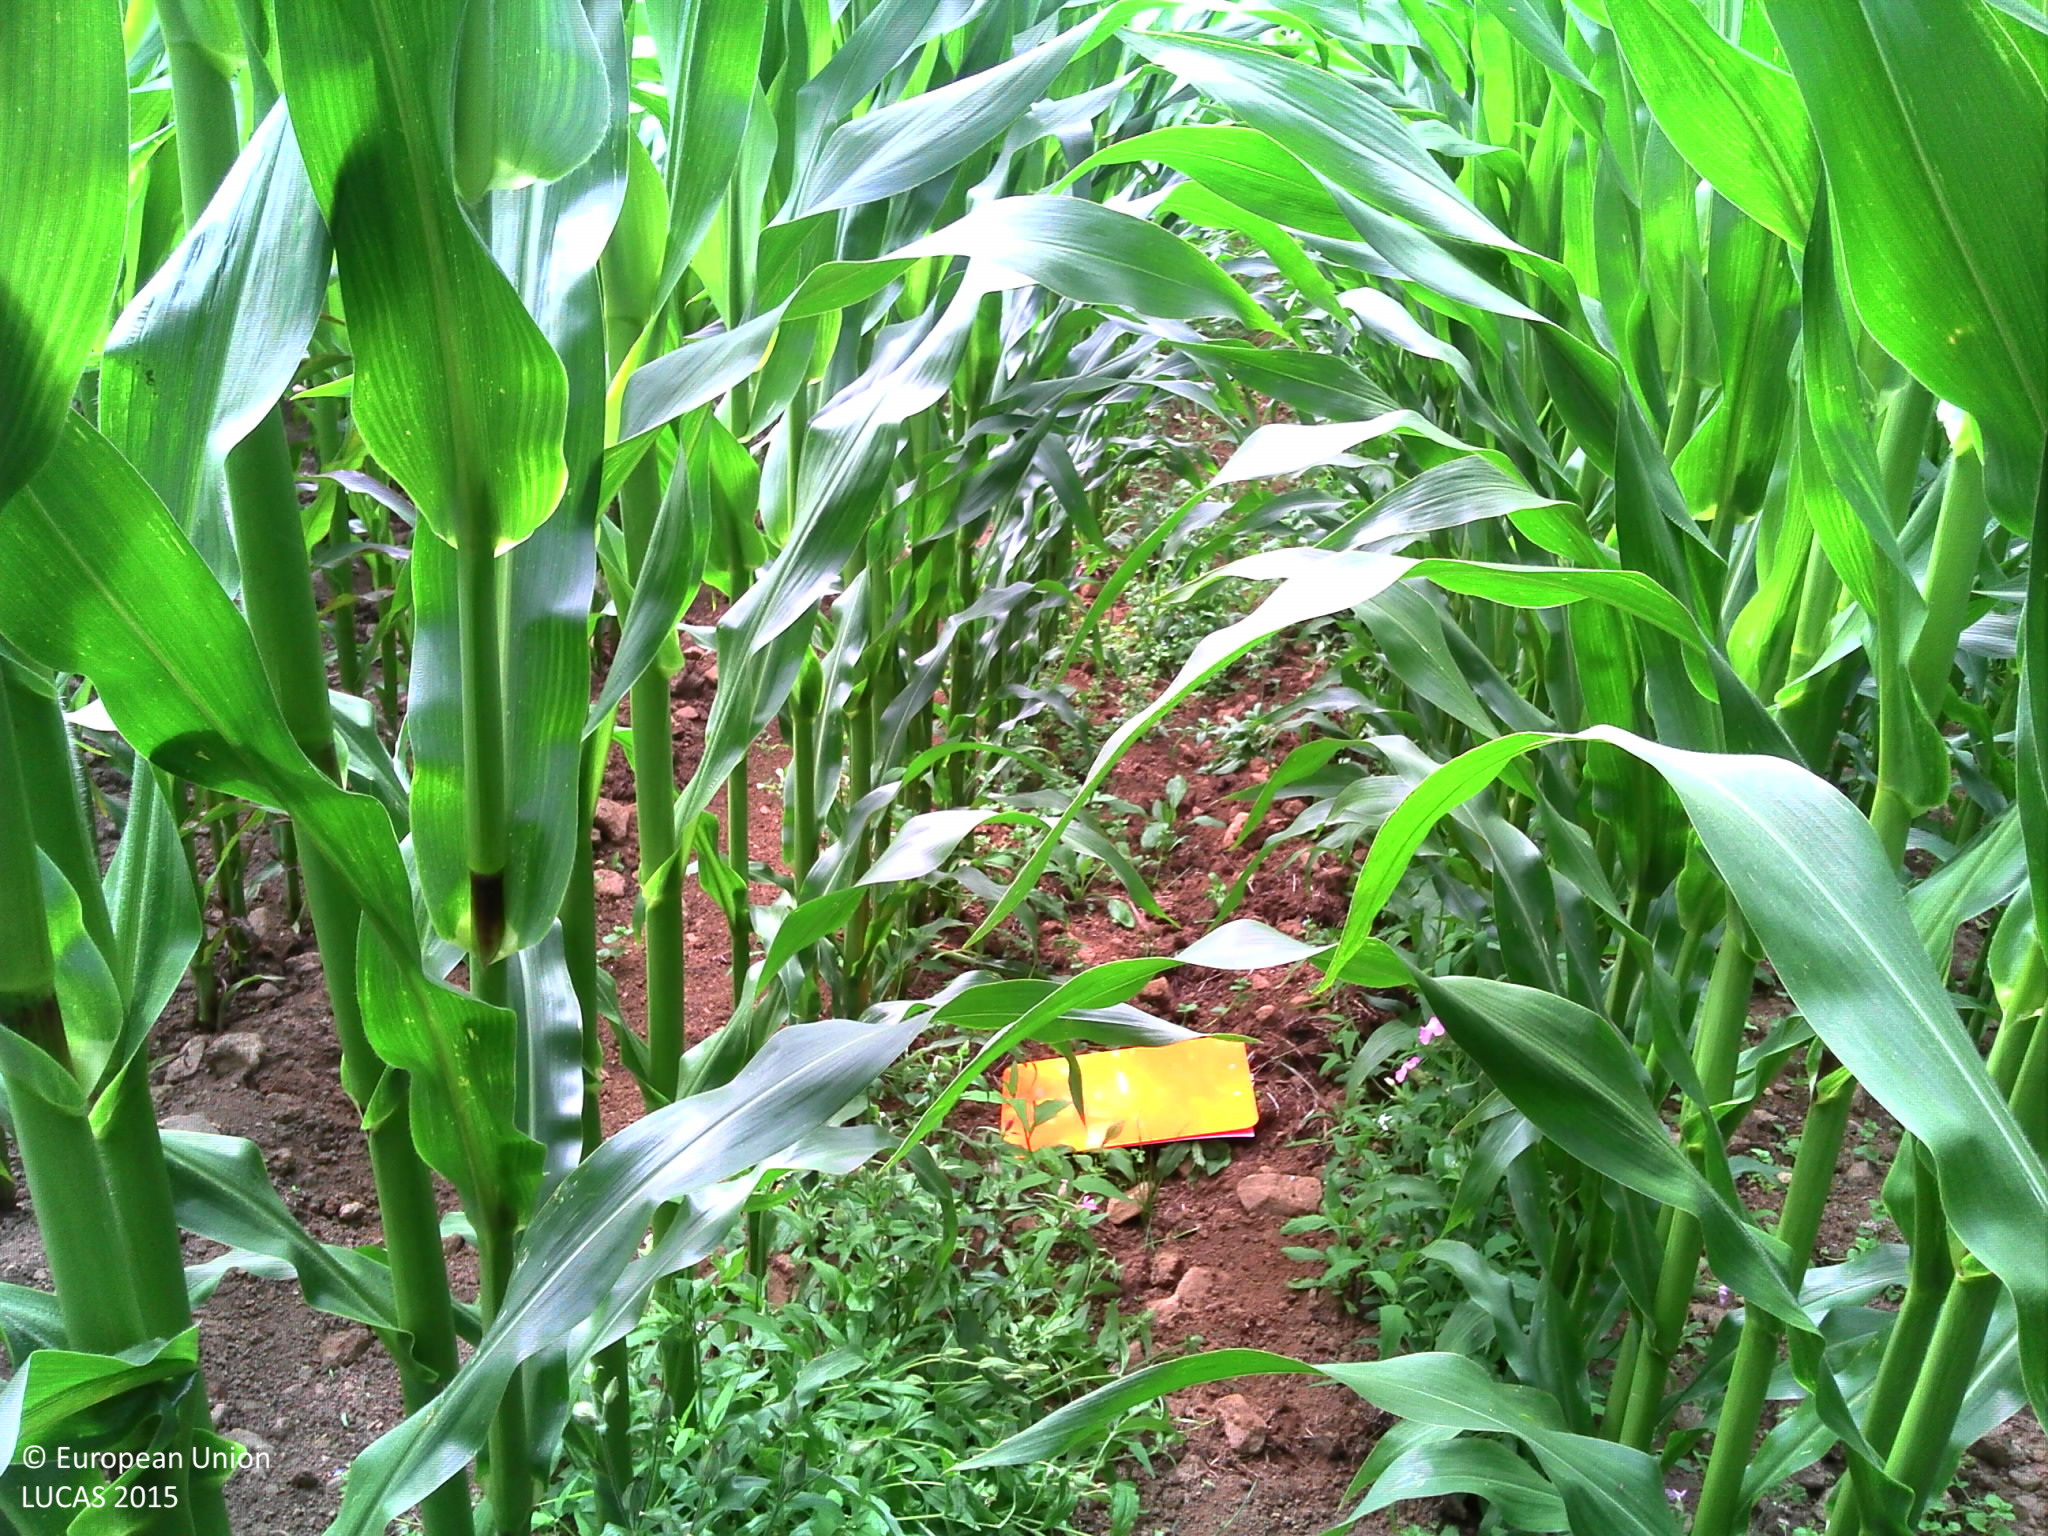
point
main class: Cropland
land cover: Maize
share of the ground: > 75 %
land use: Agriculture (excluding fallow land and kitchen gardens)
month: August
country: FR
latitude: 48.4590
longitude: -3.3969
